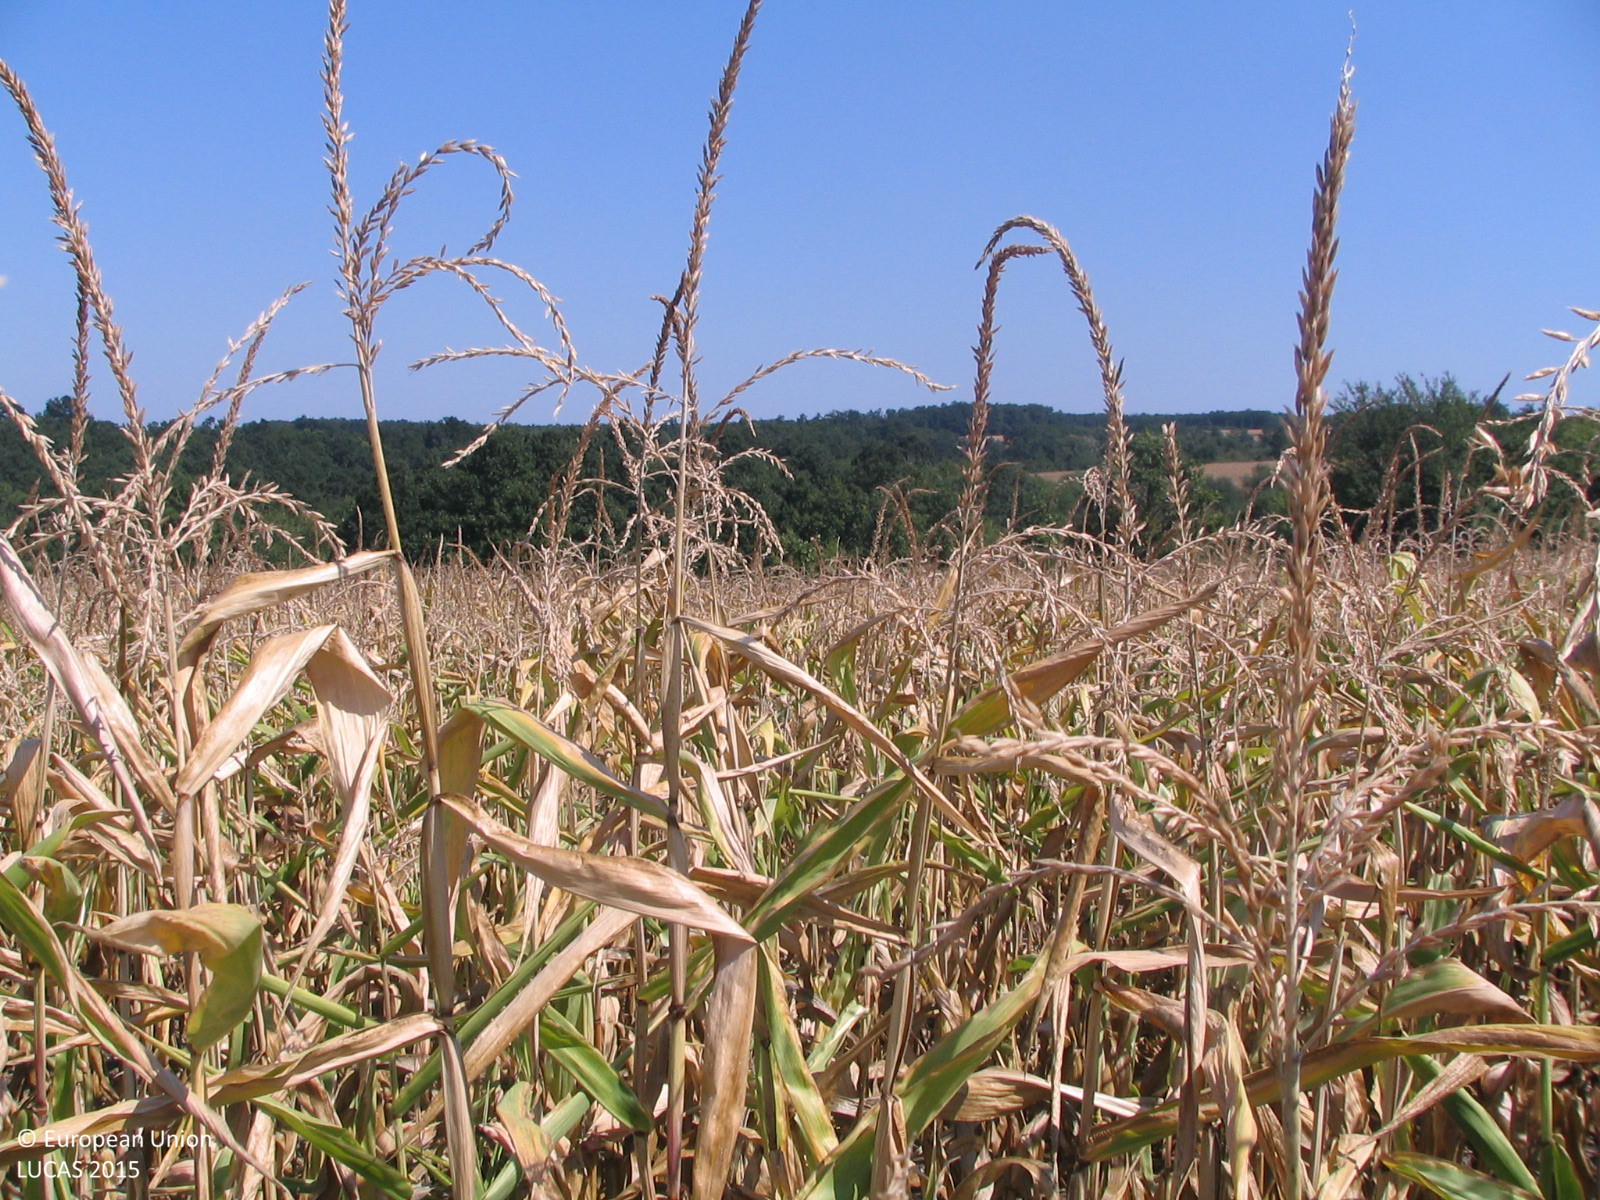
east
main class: Cropland
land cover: Maize
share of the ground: > 75 %
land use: Agriculture (excluding fallow land and kitchen gardens)
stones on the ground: < 10 %
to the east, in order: Maize; Grassland with sparse tree/shrub cover; Tracks; Groves; Grassland with sparse tree/shrub cover; Broadleaved woodland
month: August
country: BG
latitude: 43.1878
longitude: 24.4411
